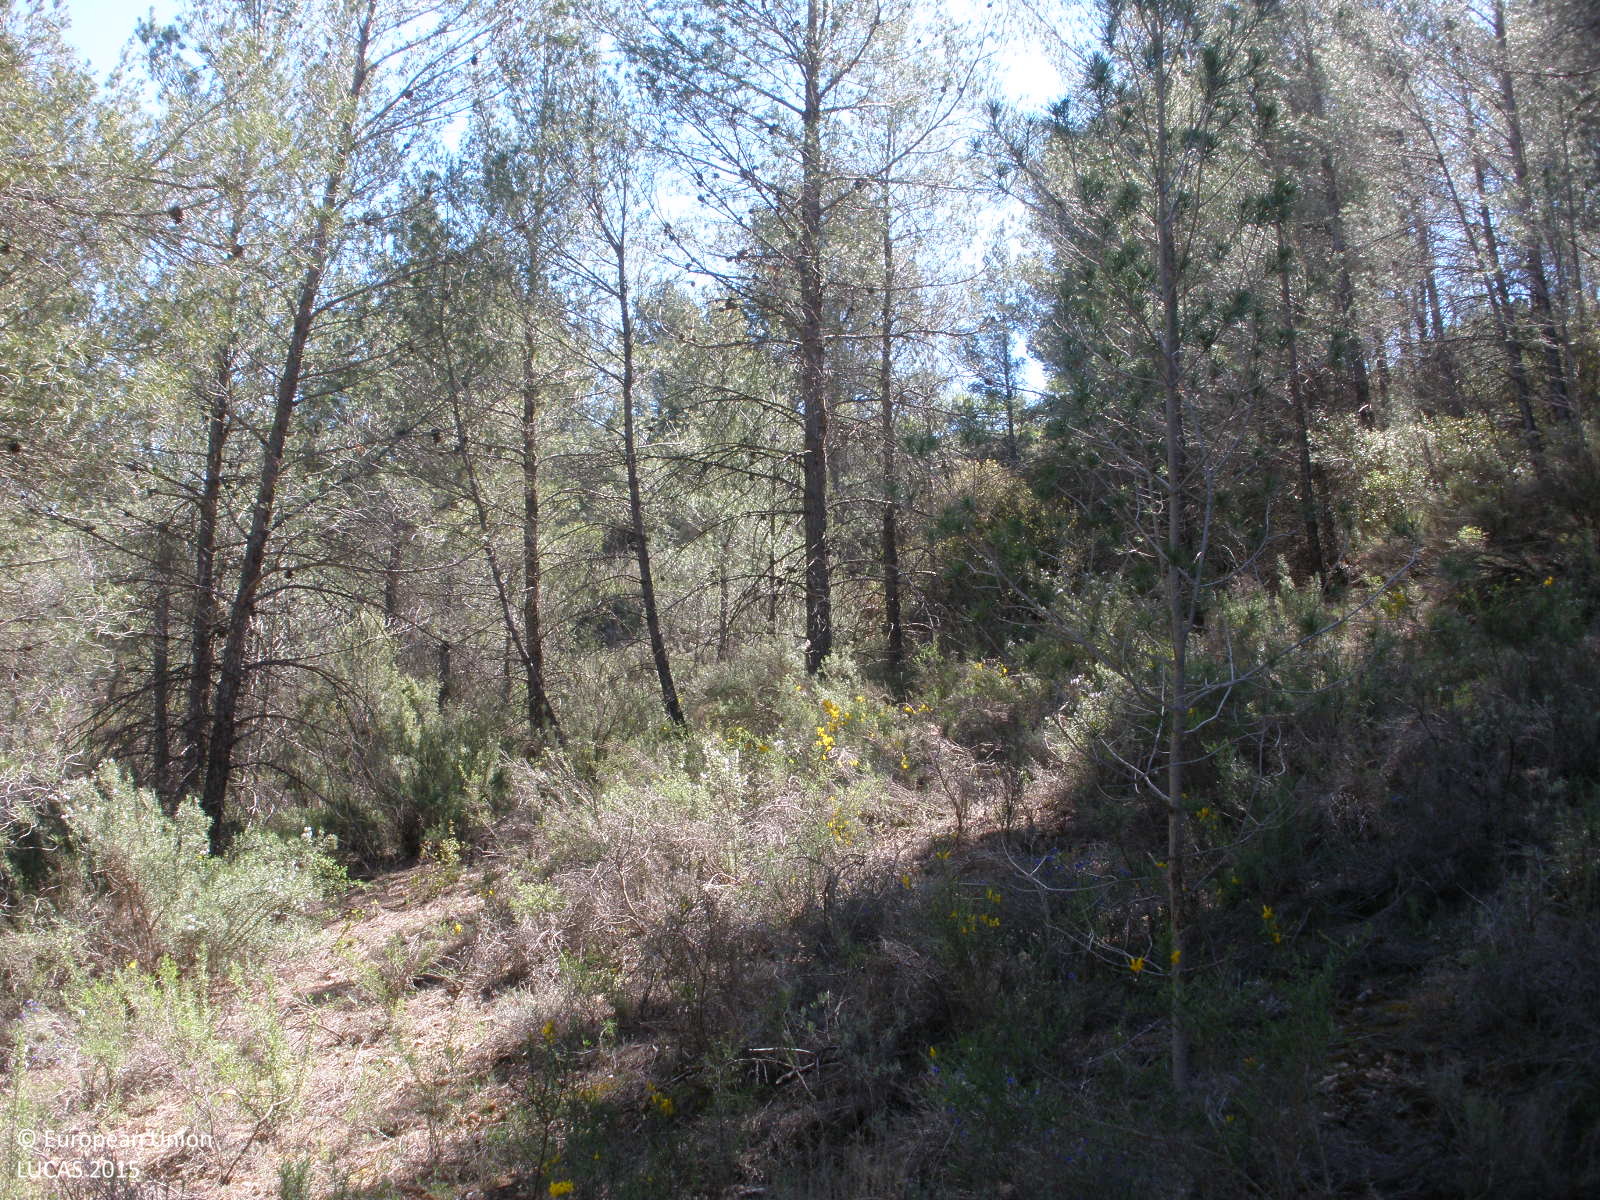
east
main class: Woodland
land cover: Pine dominated coniferous woodland
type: coniferous forest of the mediterranean region
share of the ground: 25 - 50 %
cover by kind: shrubs 60 %, coniferous forest trees 40 %
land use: Semi-natural and natural areas not in use
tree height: > 5 m
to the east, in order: Pine dominated coniferous woodland; Nuts trees
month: April
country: ES
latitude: 40.1302
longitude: -1.2402
